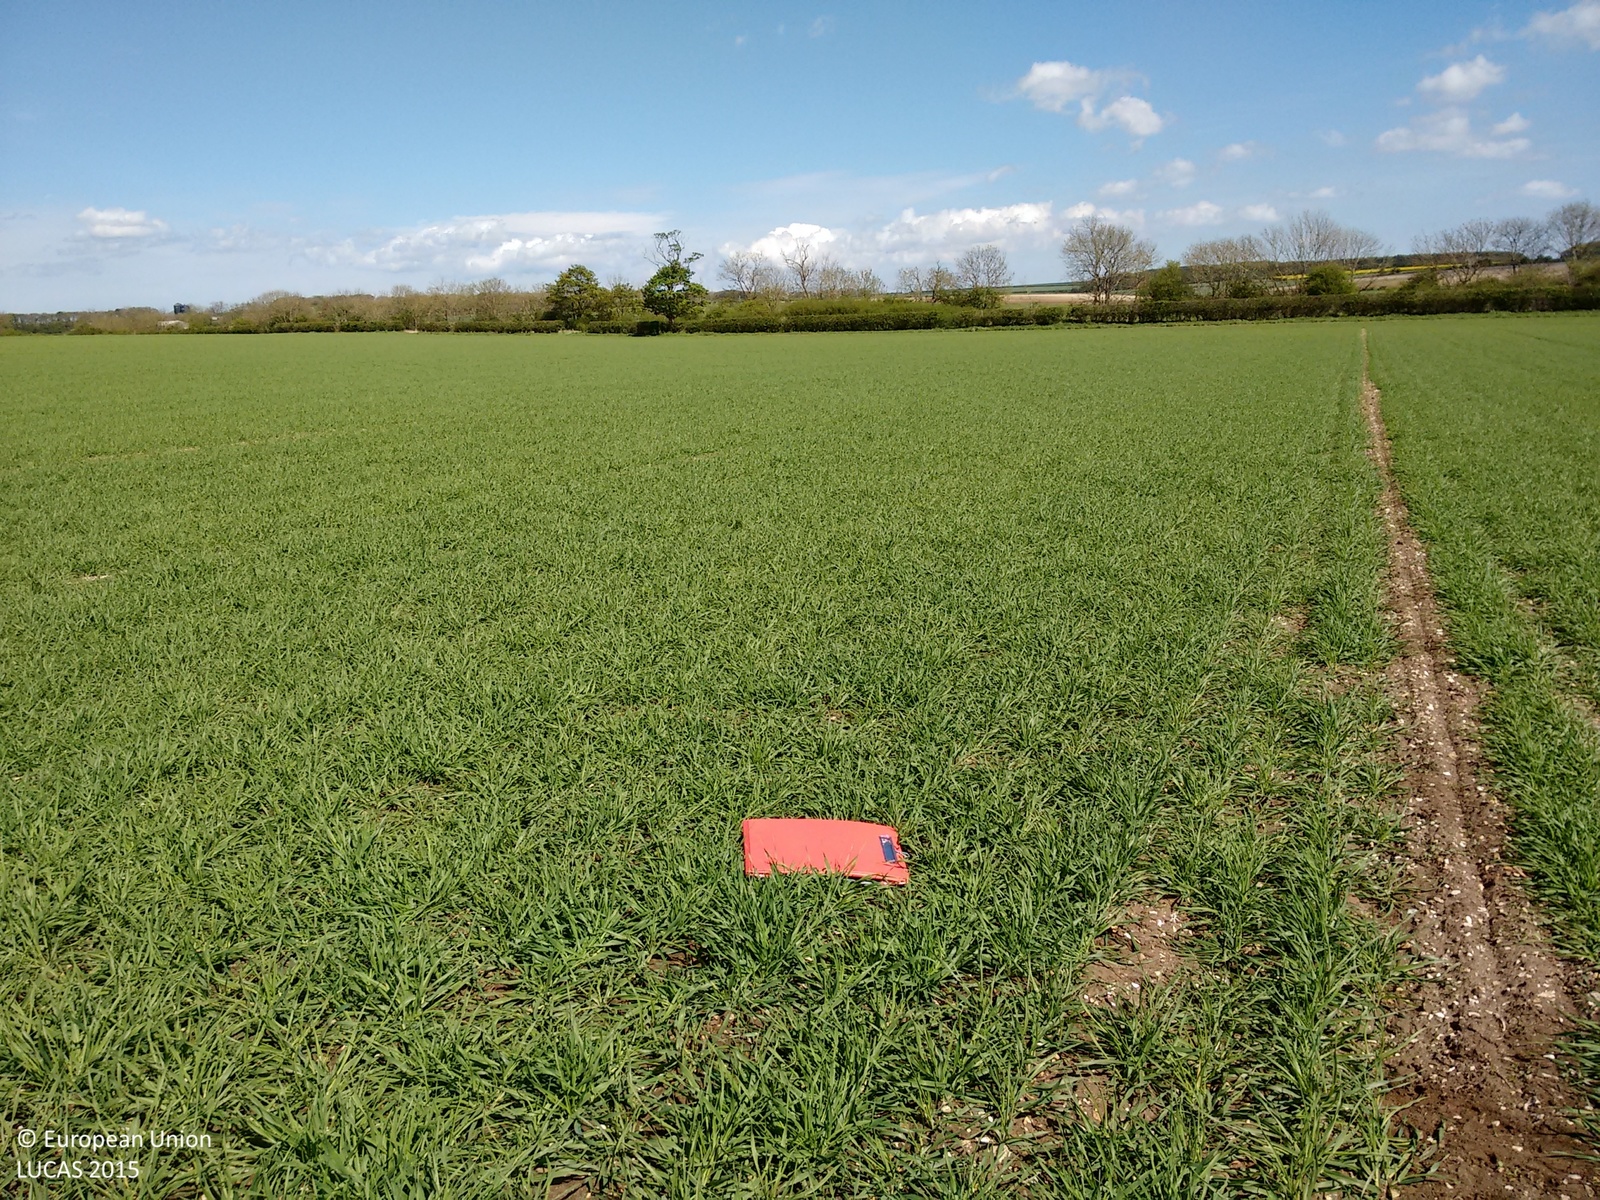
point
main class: Cropland
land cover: Barley
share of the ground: > 75 %
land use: Agriculture (excluding fallow land and kitchen gardens)
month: May
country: GB
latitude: 54.1015
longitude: -0.3265
